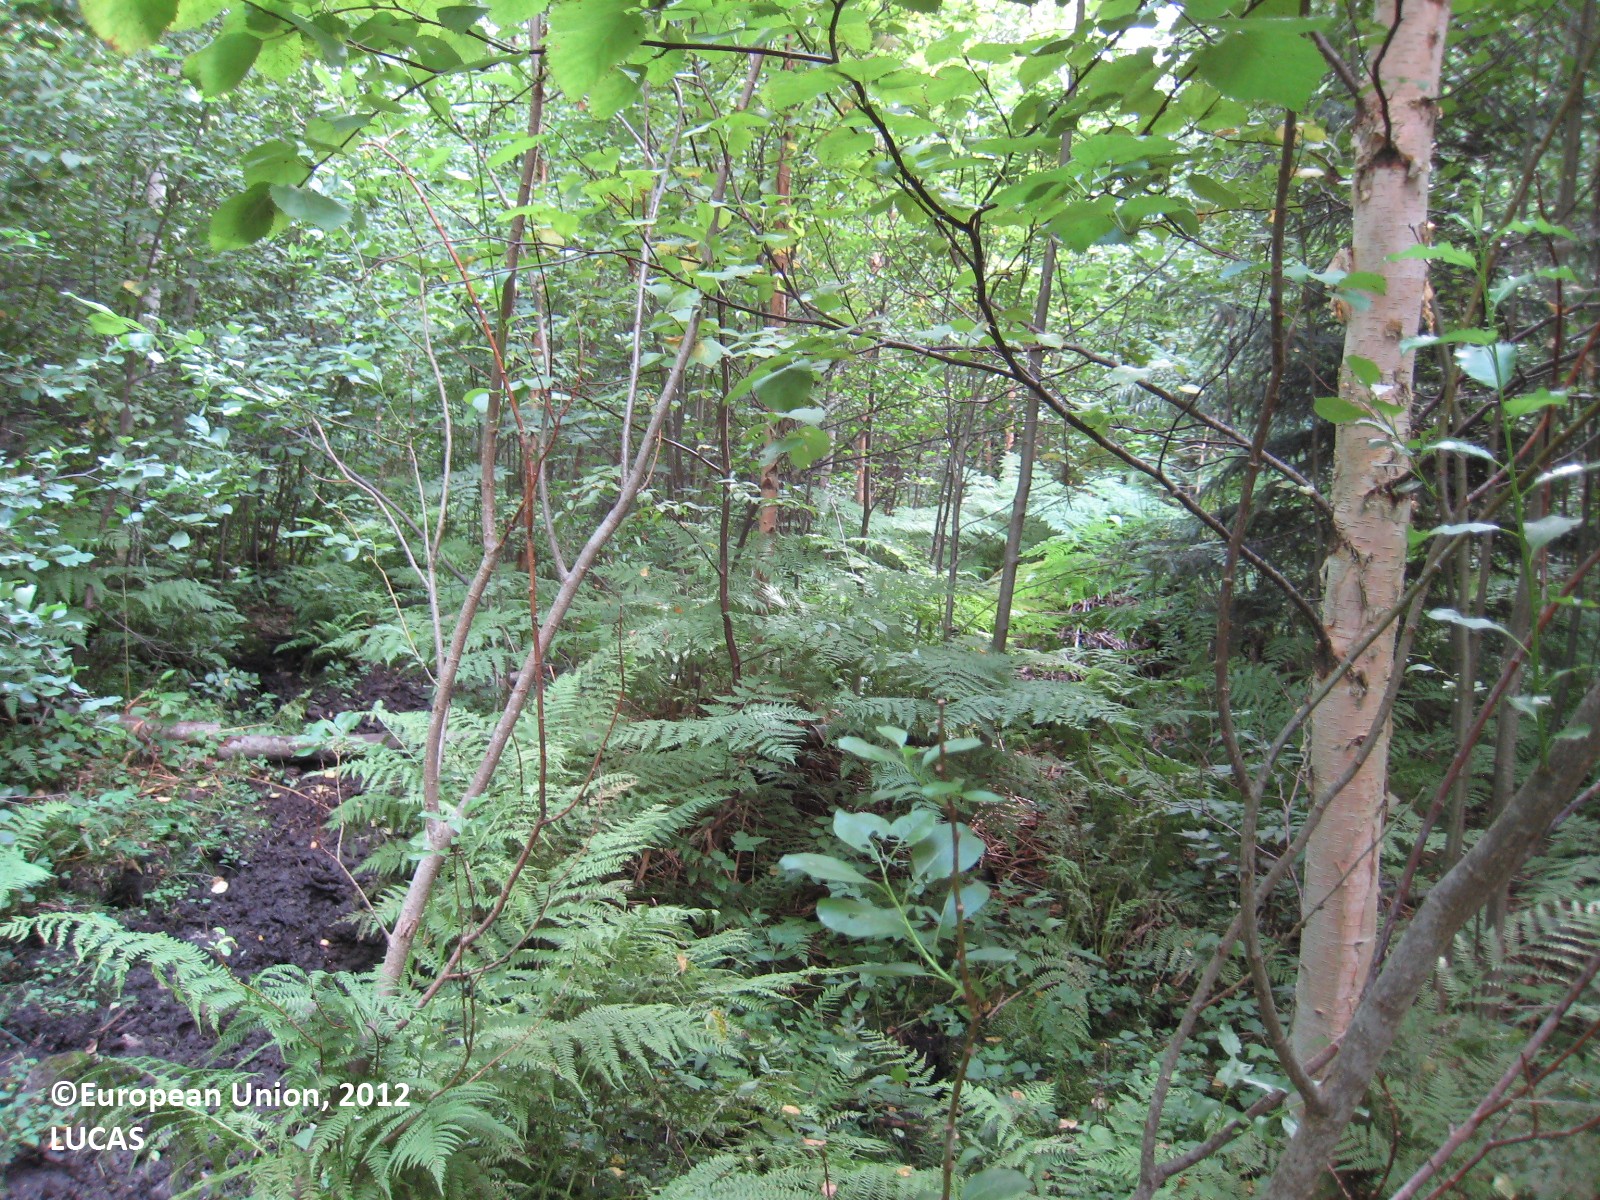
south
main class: Woodland
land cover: Broadleaved woodland
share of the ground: > 75 %
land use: Forestry
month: July
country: FI
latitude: 61.6988
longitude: 26.1117
